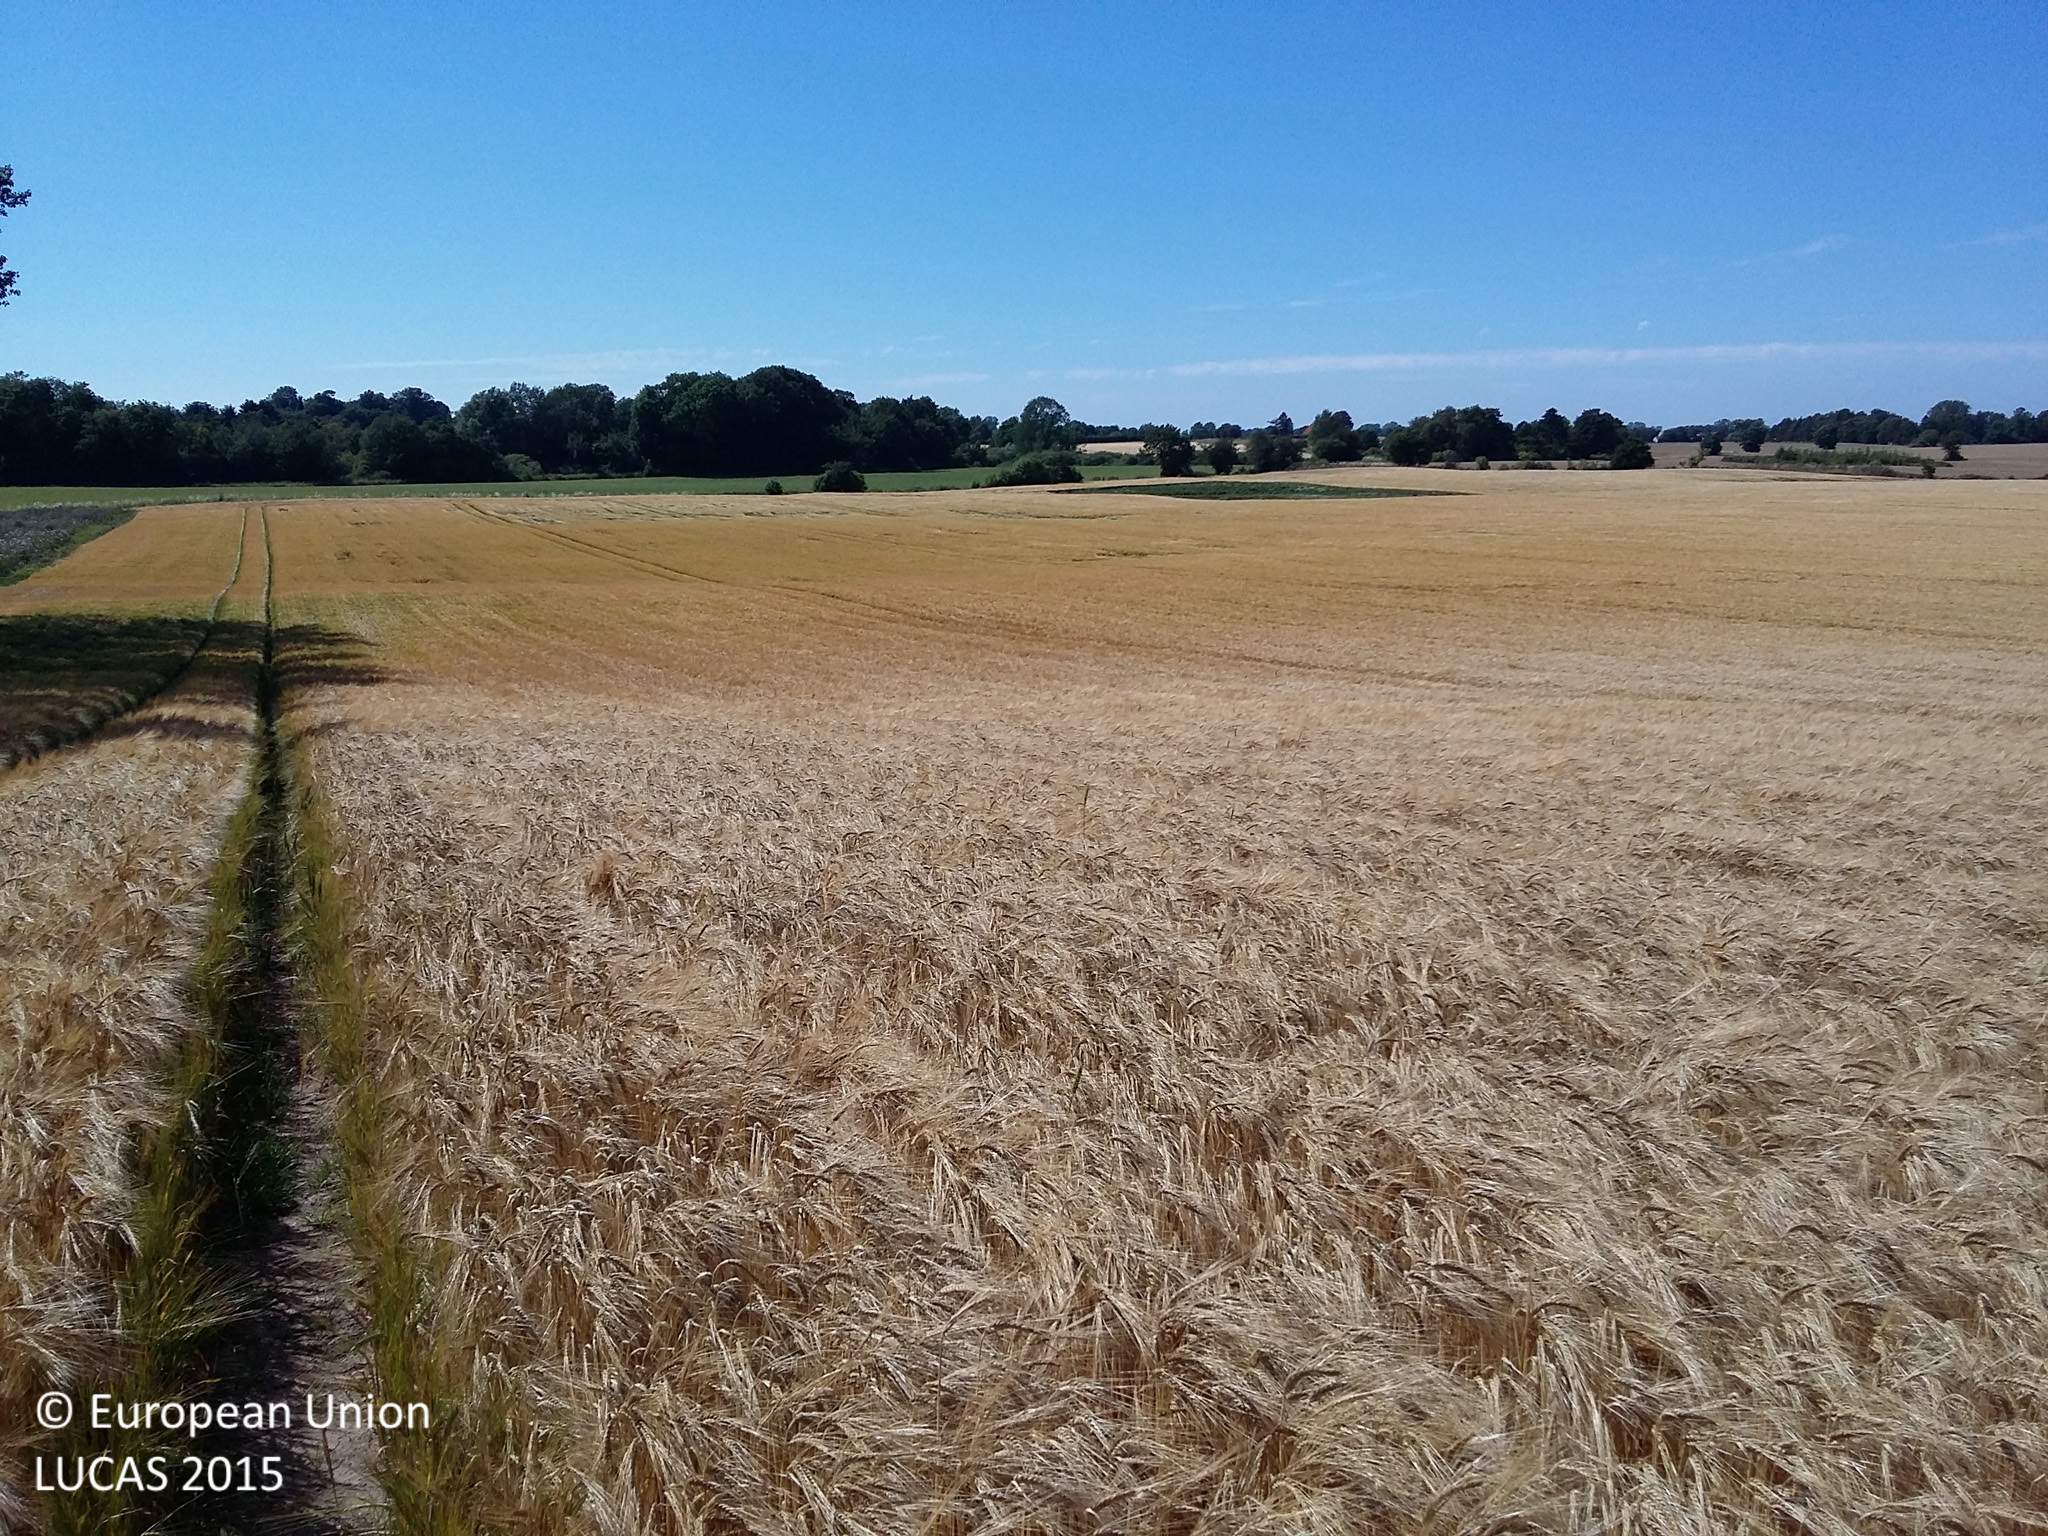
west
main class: Cropland
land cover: Barley
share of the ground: > 75 %
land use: Agriculture (excluding fallow land and kitchen gardens)
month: August
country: DK
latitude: 55.7012
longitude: 12.2099
